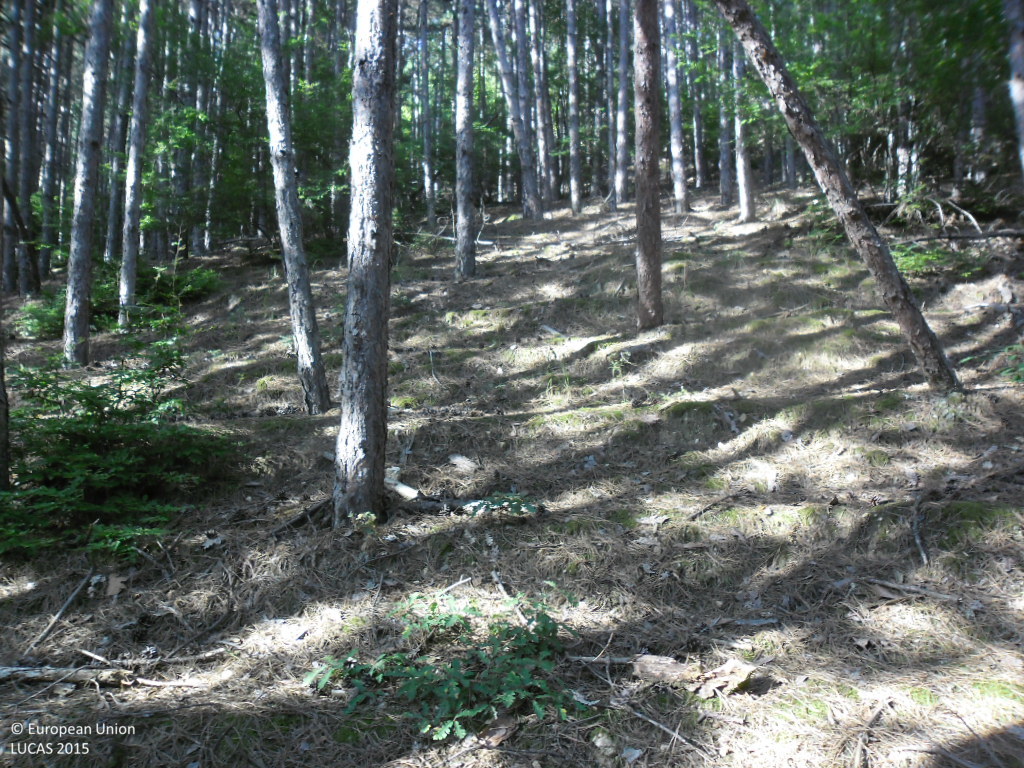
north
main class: Woodland
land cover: Pine dominated coniferous woodland
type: hemiboreal forest and nemoral coniferous forest and mixed broadleaved-coniferous forest
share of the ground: > 75 %
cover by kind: coniferous forest trees 85 %, broadleaved forest trees 10 %, unconsolidated bare surface 5 %
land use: Forestry
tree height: > 5 m
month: September
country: BG
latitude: 41.4547
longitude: 23.0785
